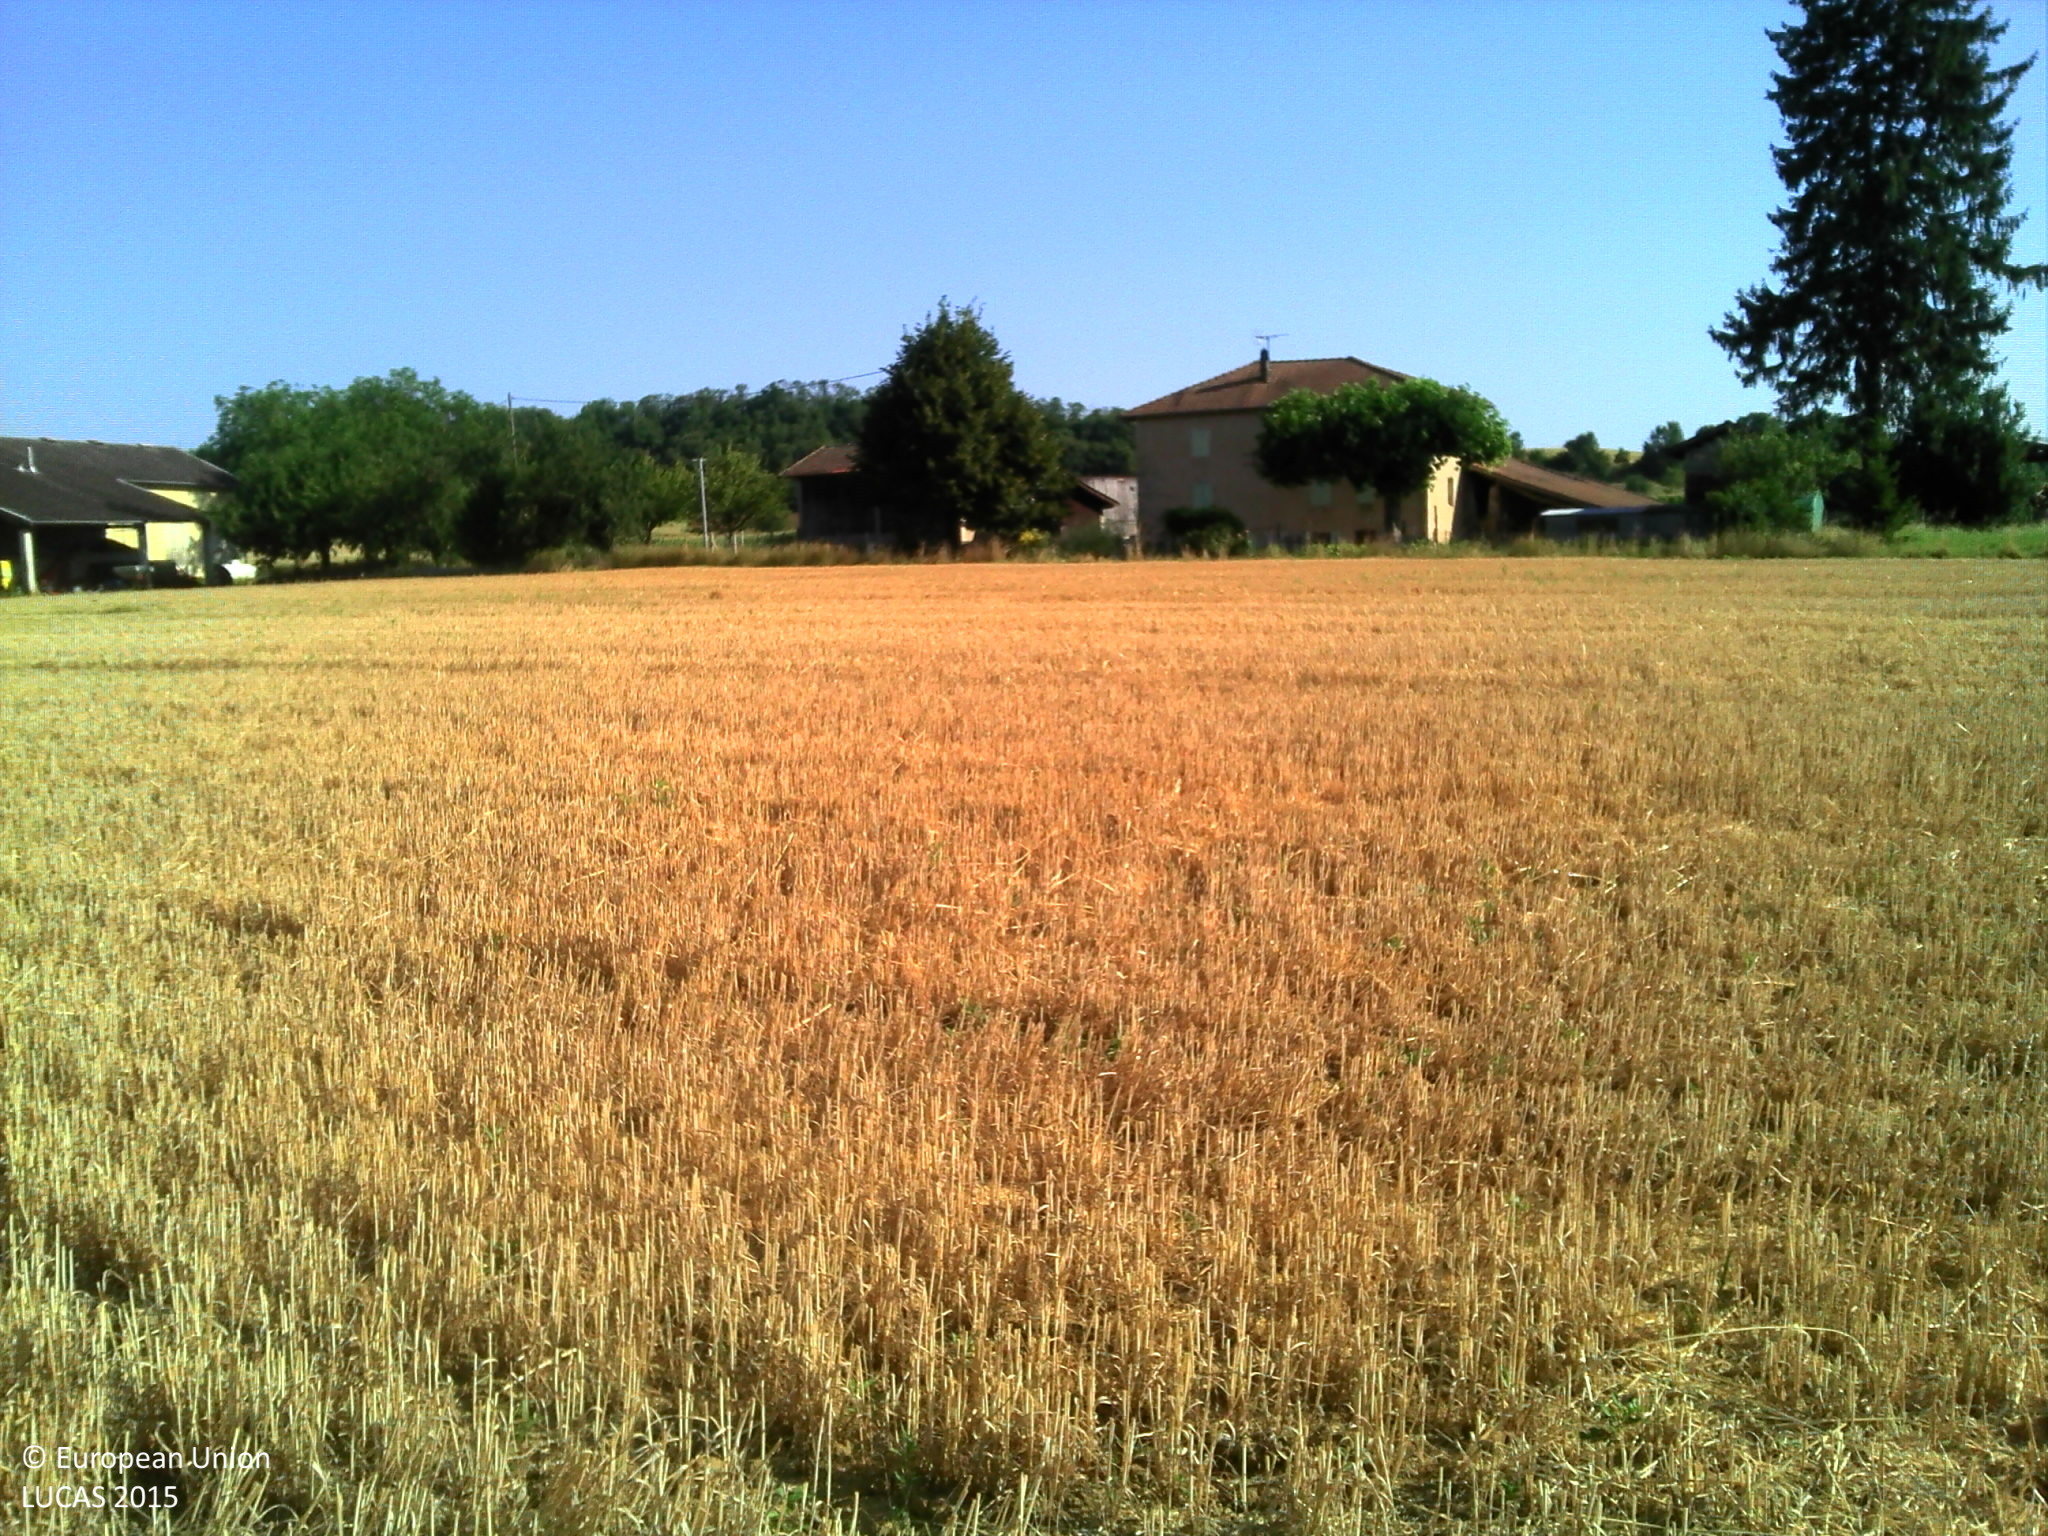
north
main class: Cropland
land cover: Durum wheat
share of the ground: > 75 %
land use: Agriculture (excluding fallow land and kitchen gardens)
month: July
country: FR
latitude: 45.1071
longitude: 5.2139
